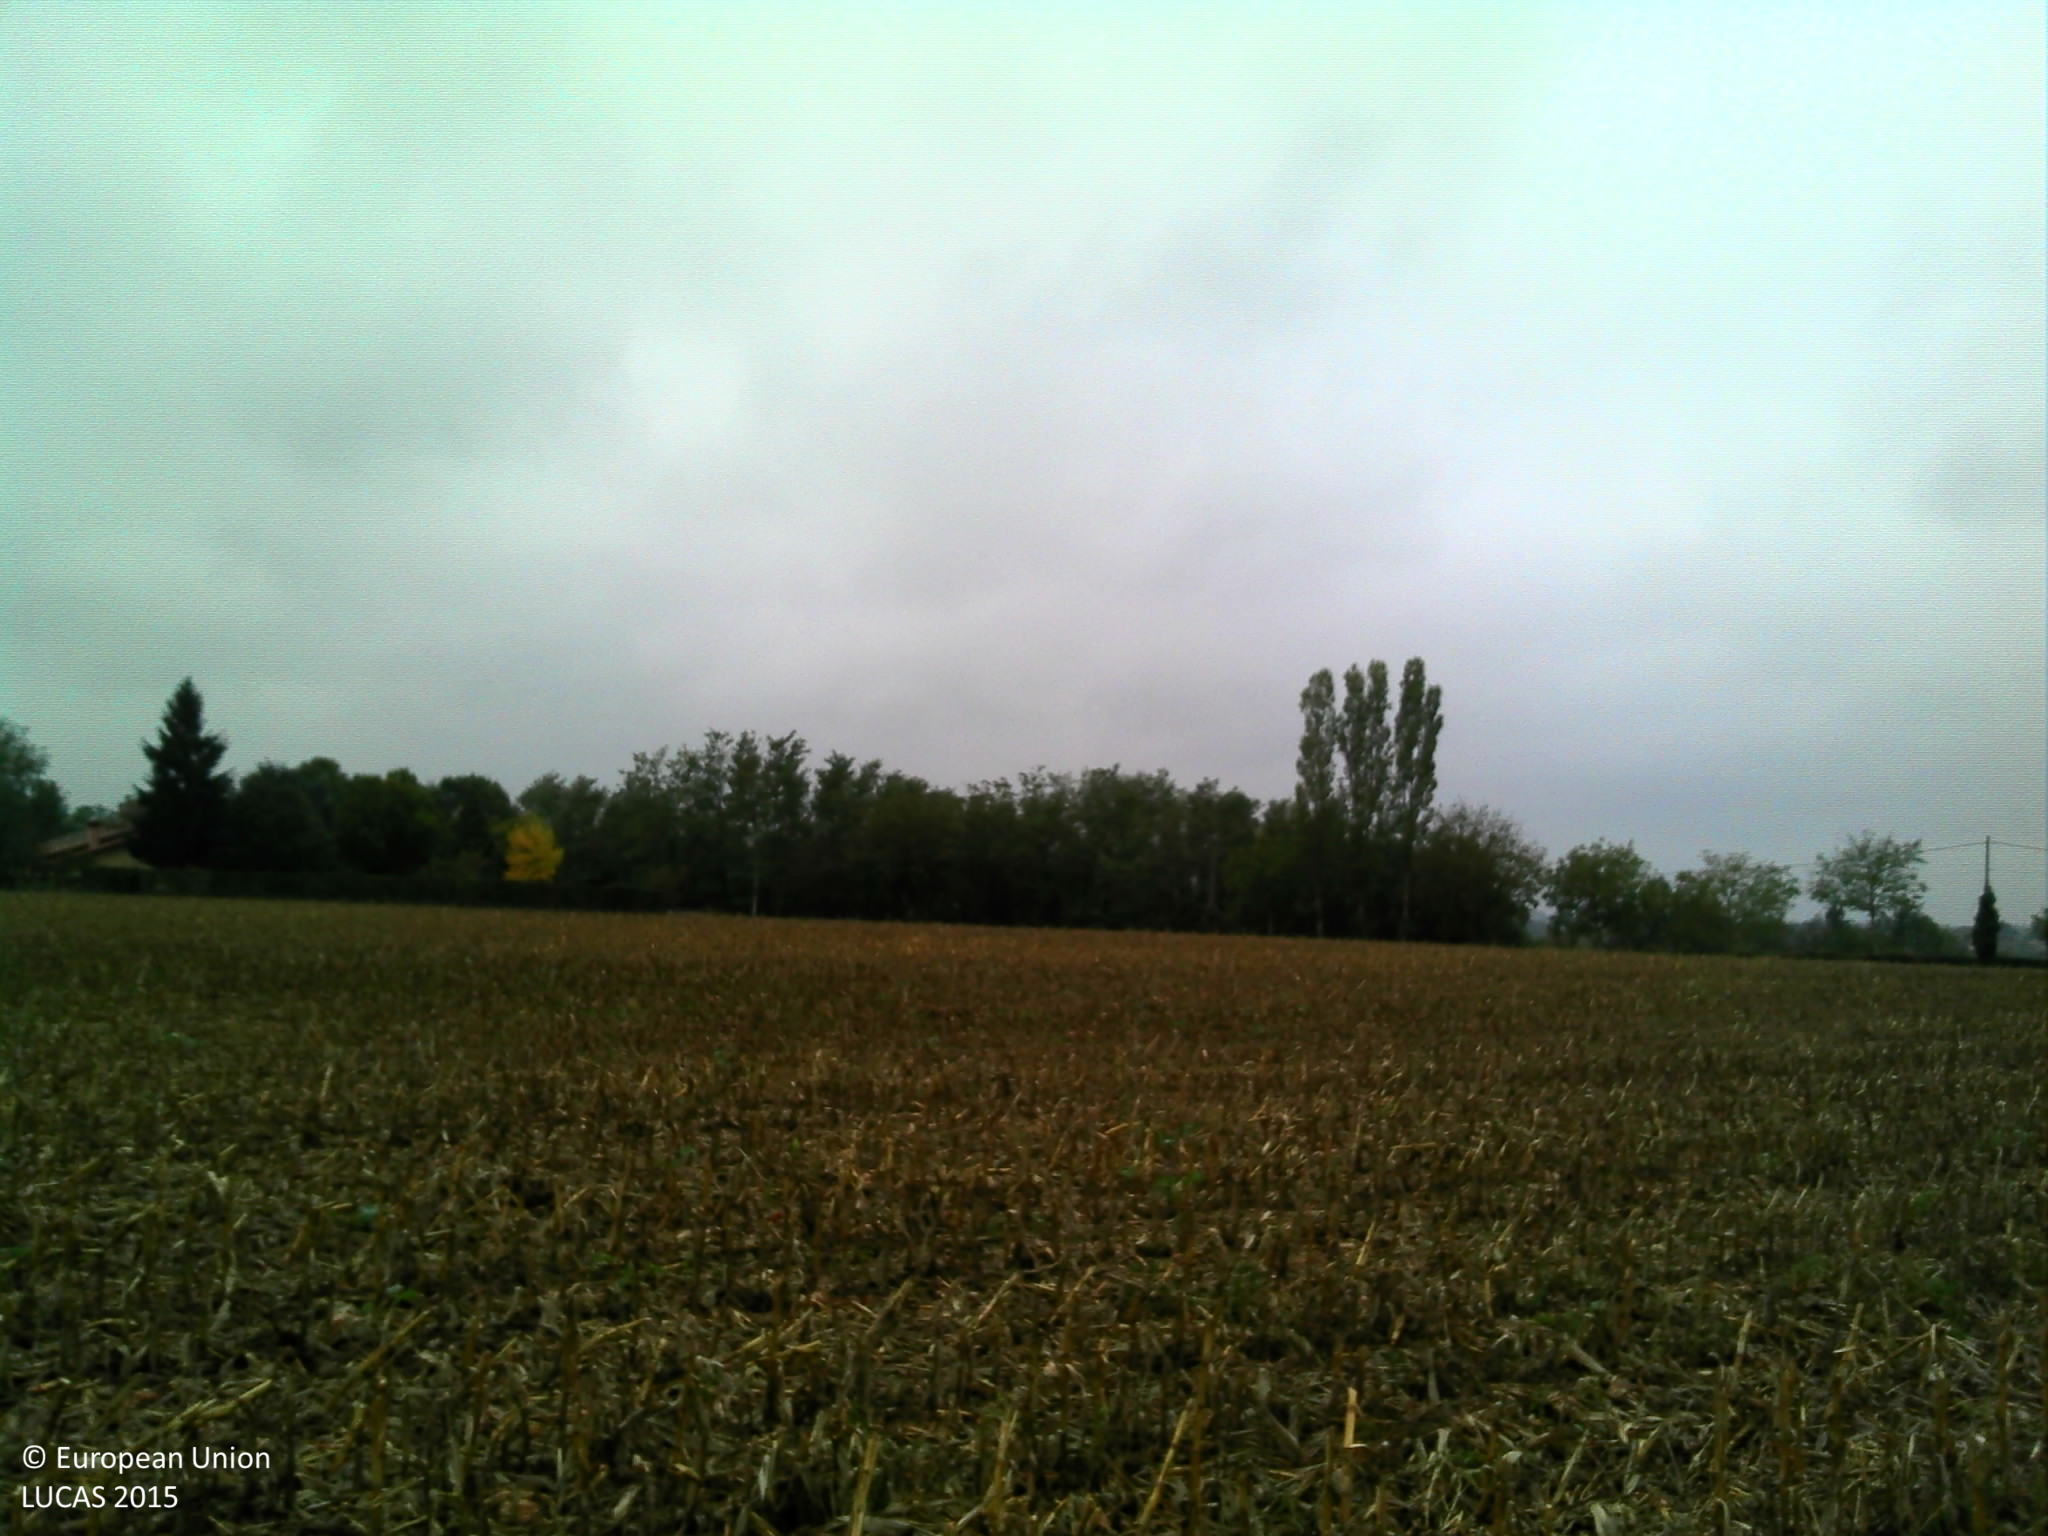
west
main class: Cropland
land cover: Maize
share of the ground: > 75 %
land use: Agriculture (excluding fallow land and kitchen gardens)
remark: Harvested field
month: October
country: FR
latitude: 46.1926
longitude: 5.2736
